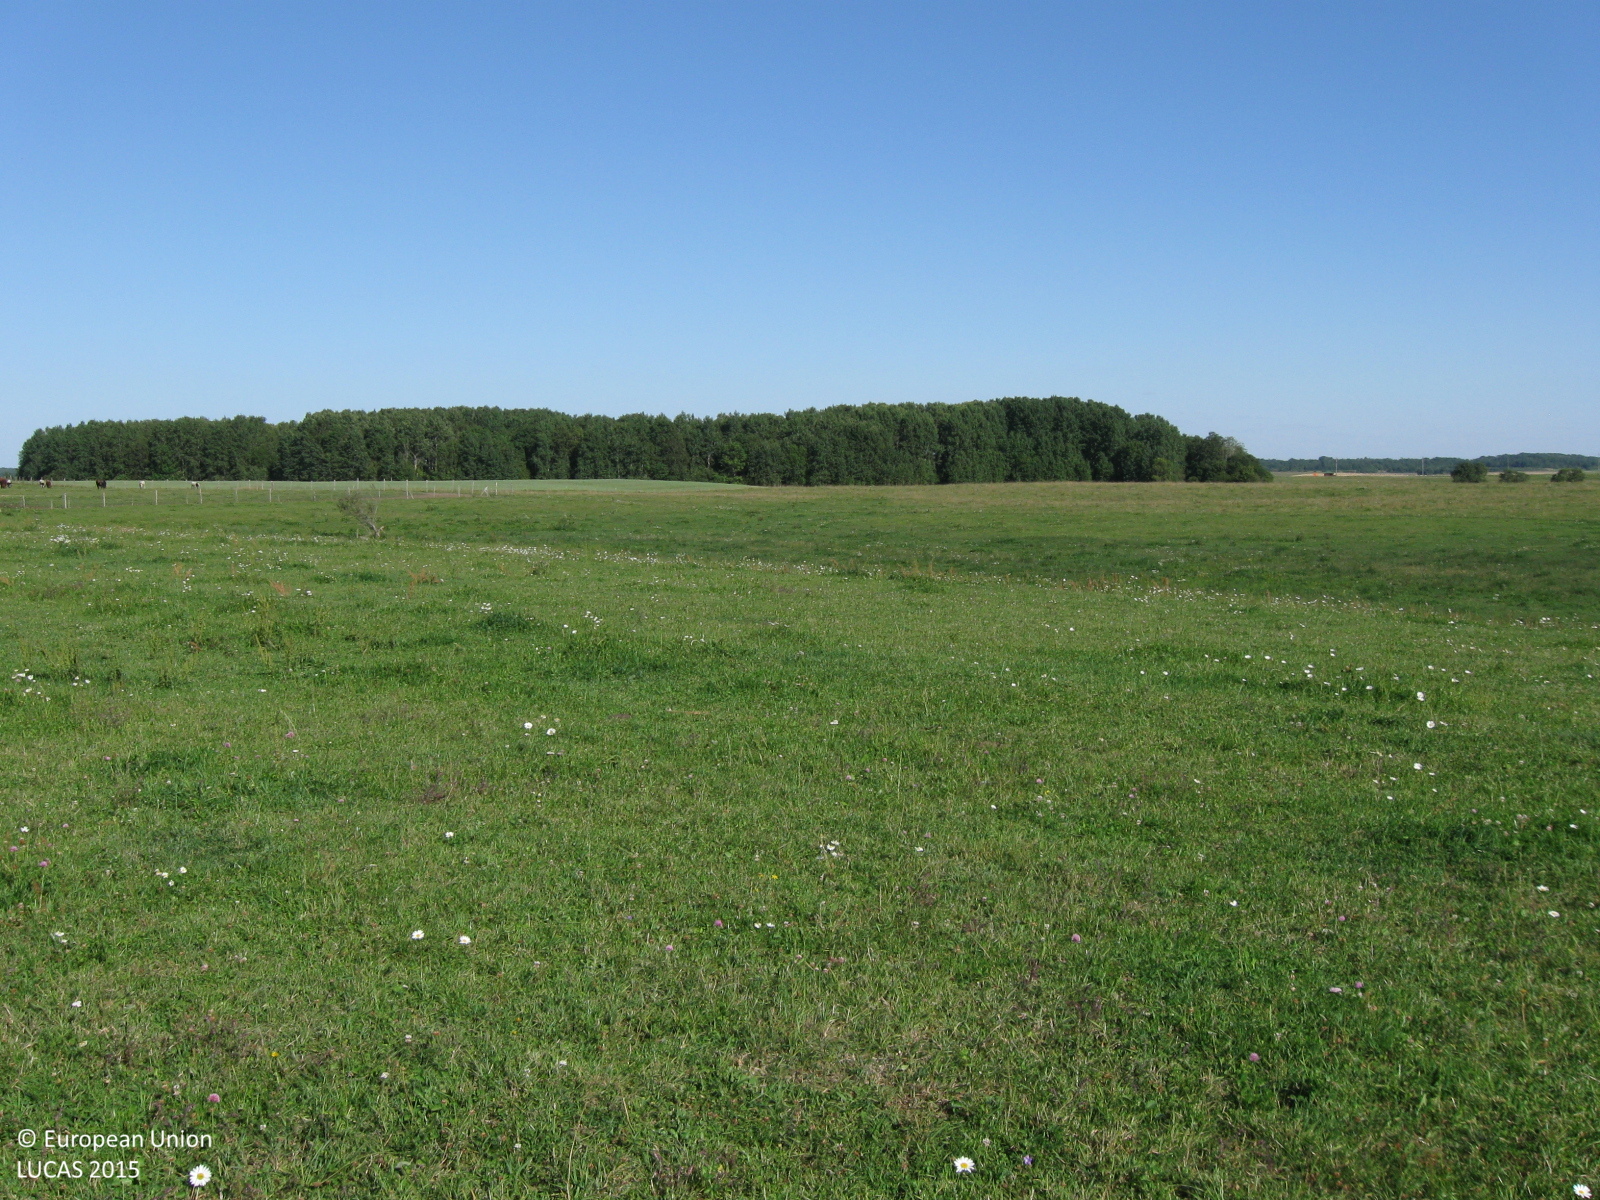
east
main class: Grassland
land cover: Grassland without tree/shrub cover
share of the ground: > 75 %
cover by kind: herbaceous plants 100 %
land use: Agriculture (excluding fallow land and kitchen gardens)
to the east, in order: Grassland without tree/shrub cover; Tracks; Grassland without tree/shrub cover
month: August
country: LT
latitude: 55.5340
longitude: 22.5309
